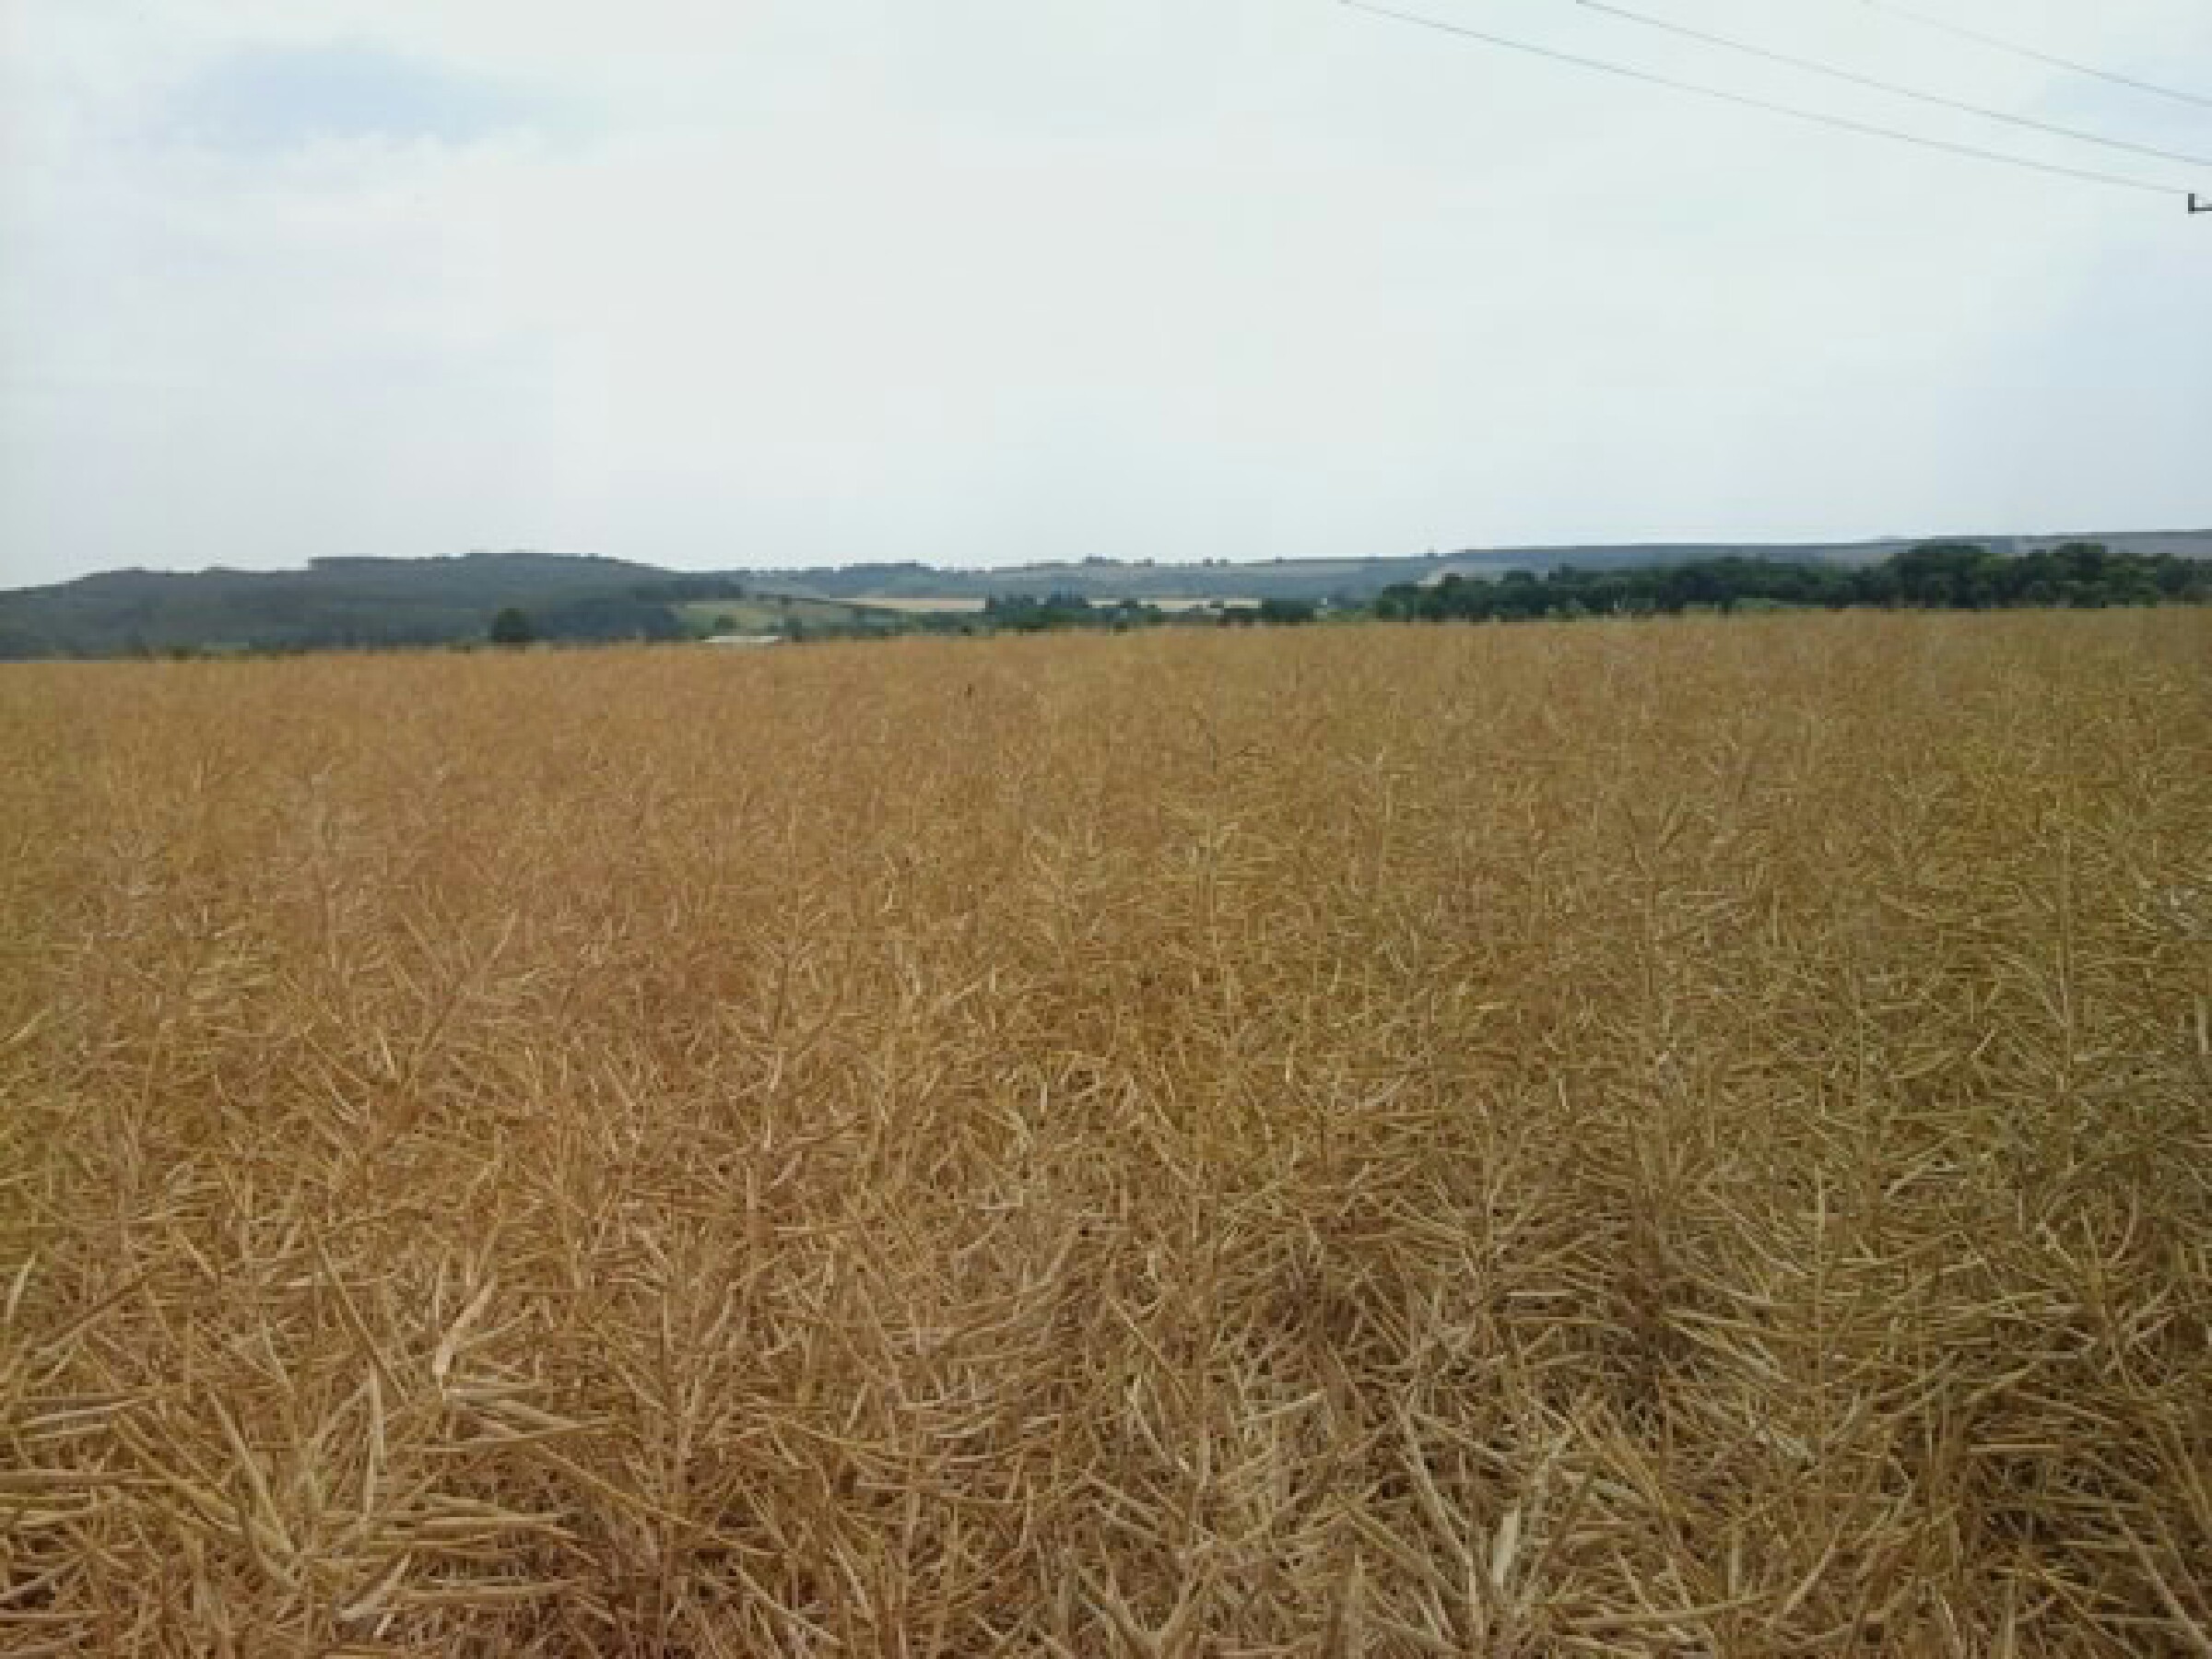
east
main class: Cropland
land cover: Rape and turnip rape
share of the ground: > 75 %
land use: Agriculture (excluding fallow land and kitchen gardens)
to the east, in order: Rape and turnip rape; Electric lines; Rape and turnip rape; Spontaneously vegetated surfaces; Fences; Lucerne
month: July
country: HU
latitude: 47.8493
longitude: 19.2821
